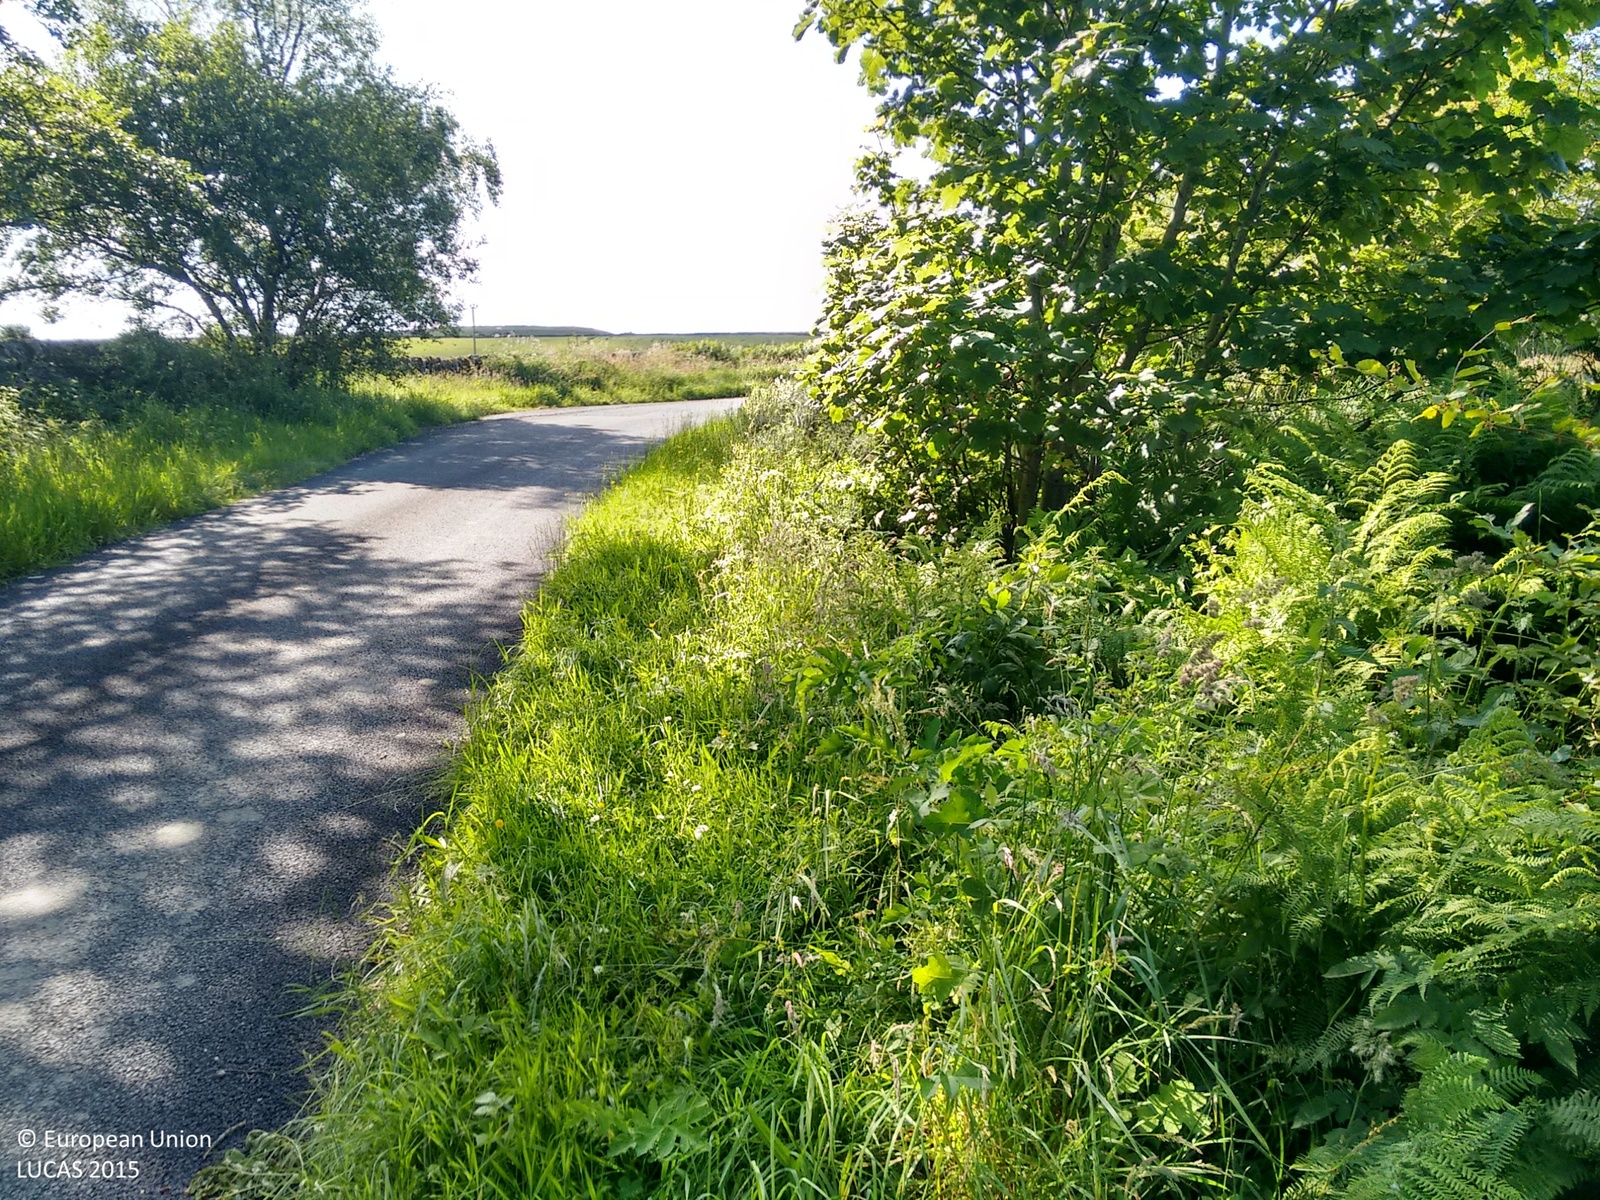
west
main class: Grassland
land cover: Grassland without tree/shrub cover
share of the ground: > 75 %
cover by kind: herbaceous plants 100 %
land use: Agriculture (excluding fallow land and kitchen gardens)
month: July
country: GB
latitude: 55.8396
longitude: -5.0749
